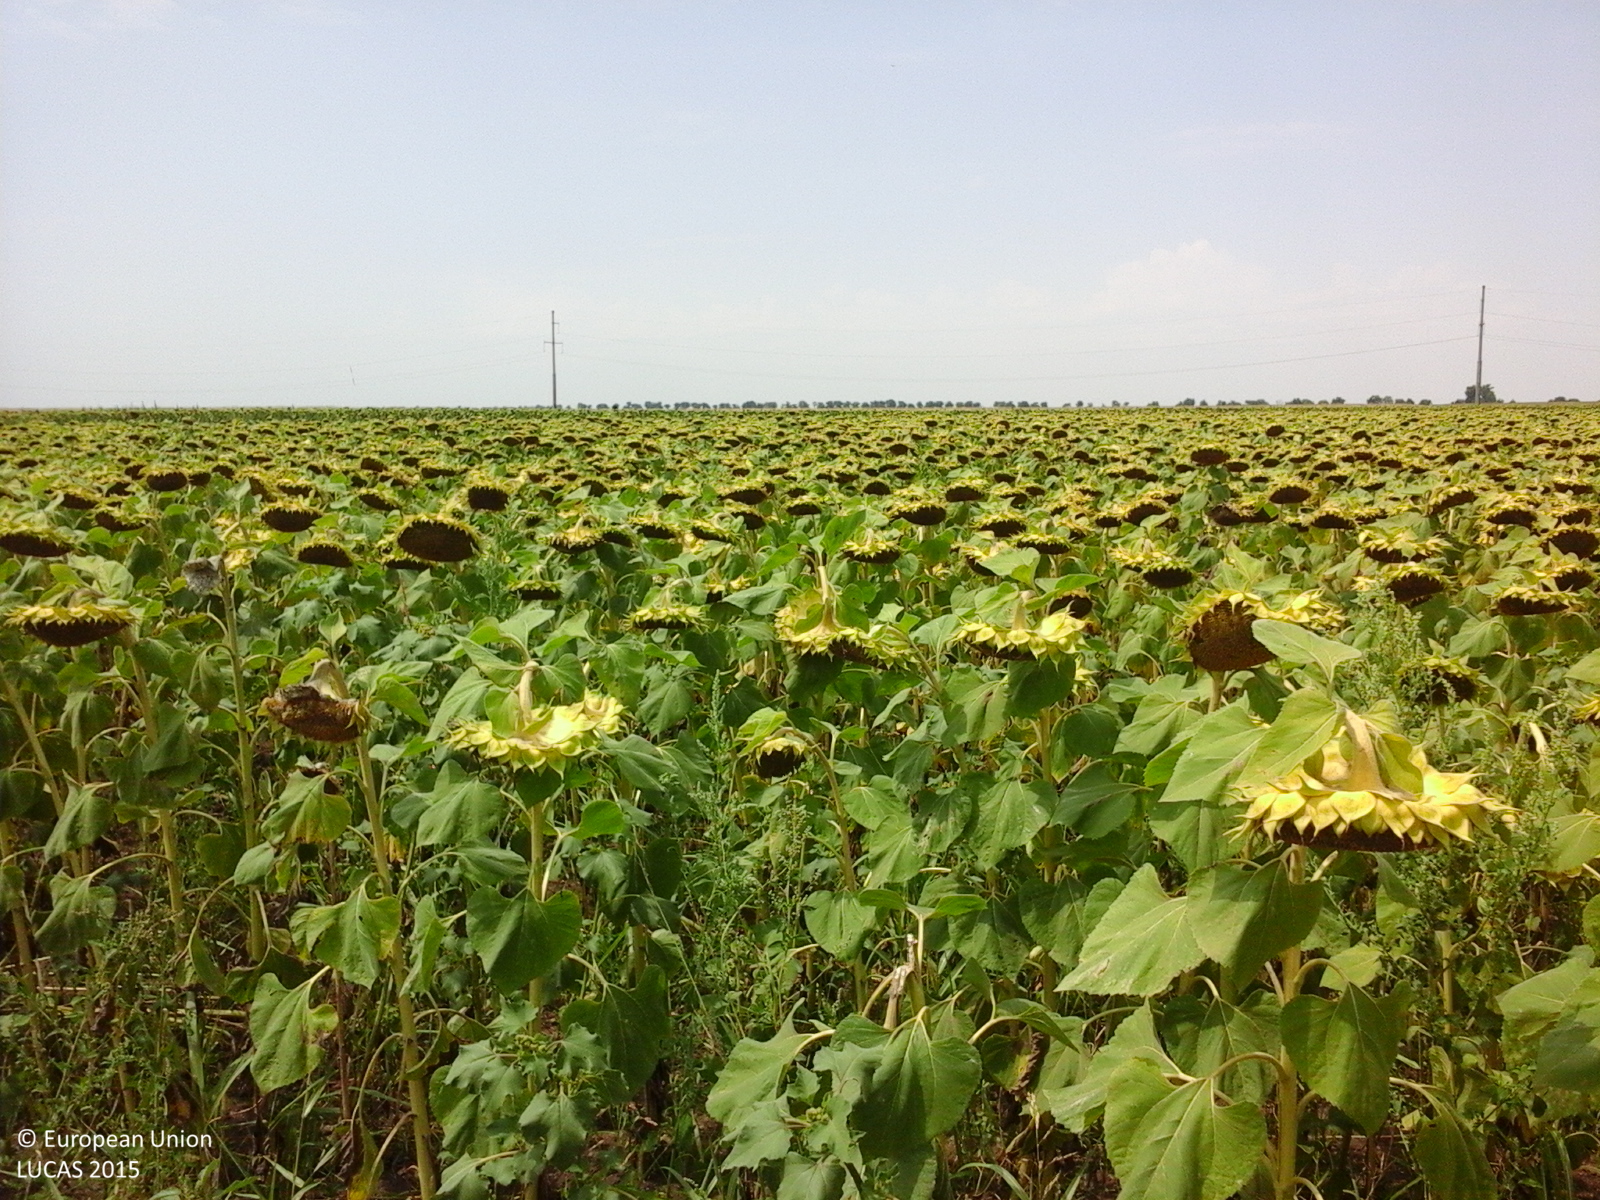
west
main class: Cropland
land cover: Sunflower
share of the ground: > 75 %
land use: Agriculture (excluding fallow land and kitchen gardens)
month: August
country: RO
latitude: 43.9447
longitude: 28.3913
